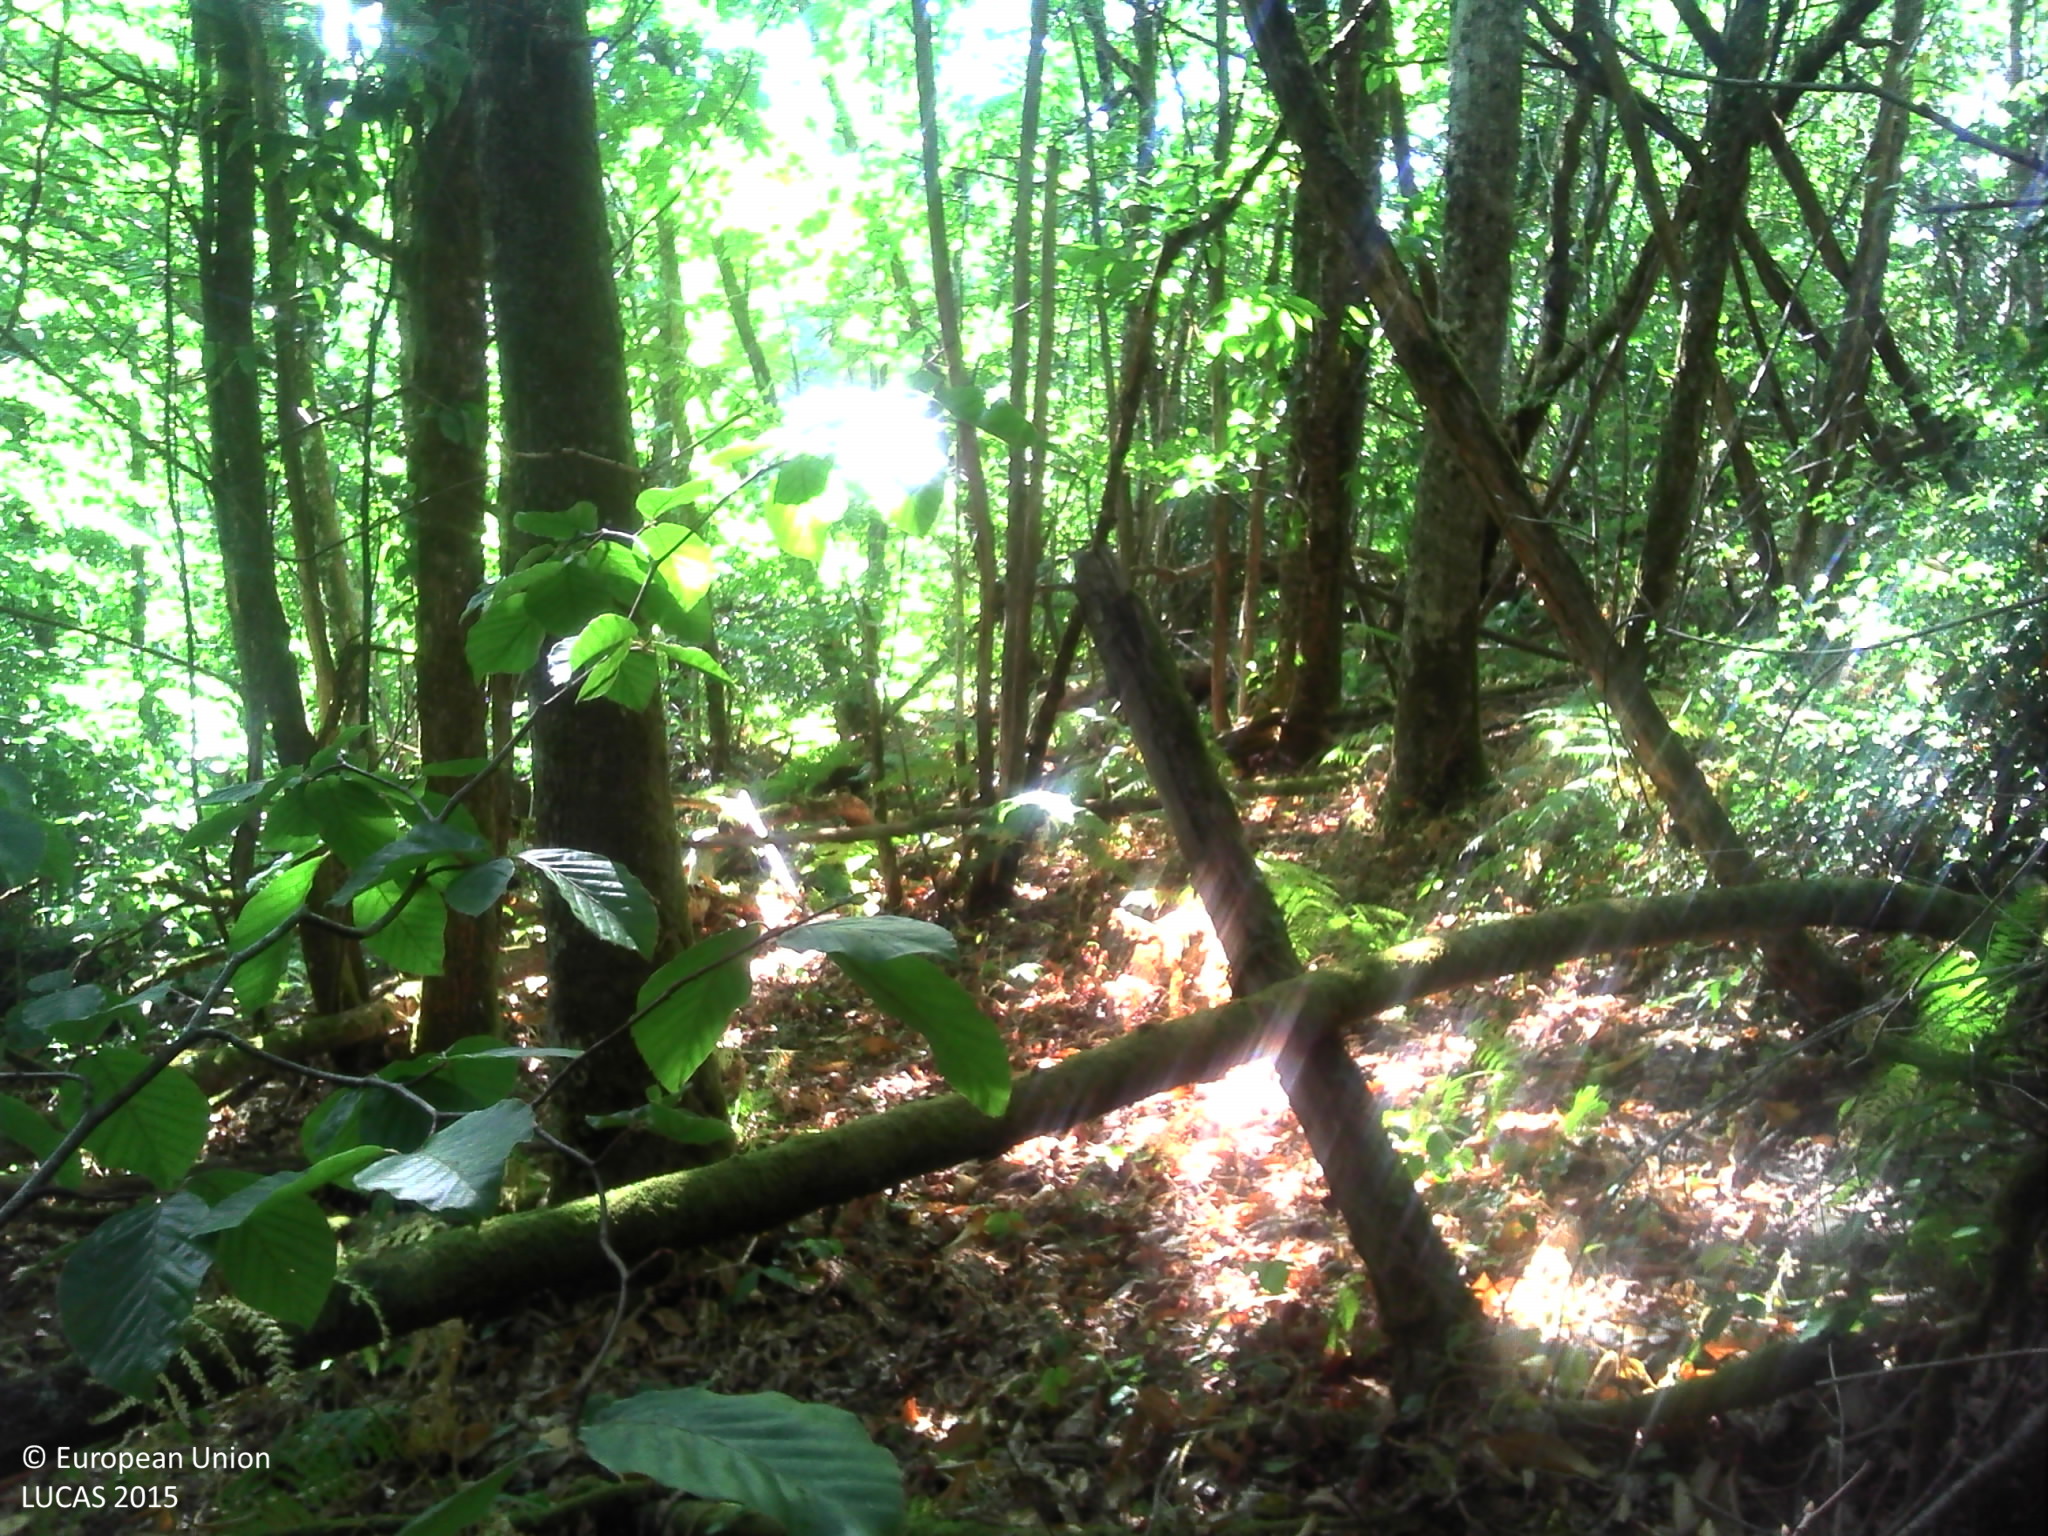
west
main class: Woodland
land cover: Broadleaved woodland
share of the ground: > 75 %
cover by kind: broadleaved forest trees 100 %
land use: Forestry
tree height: > 5 m
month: July
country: FR
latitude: 45.9906
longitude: 1.0159
